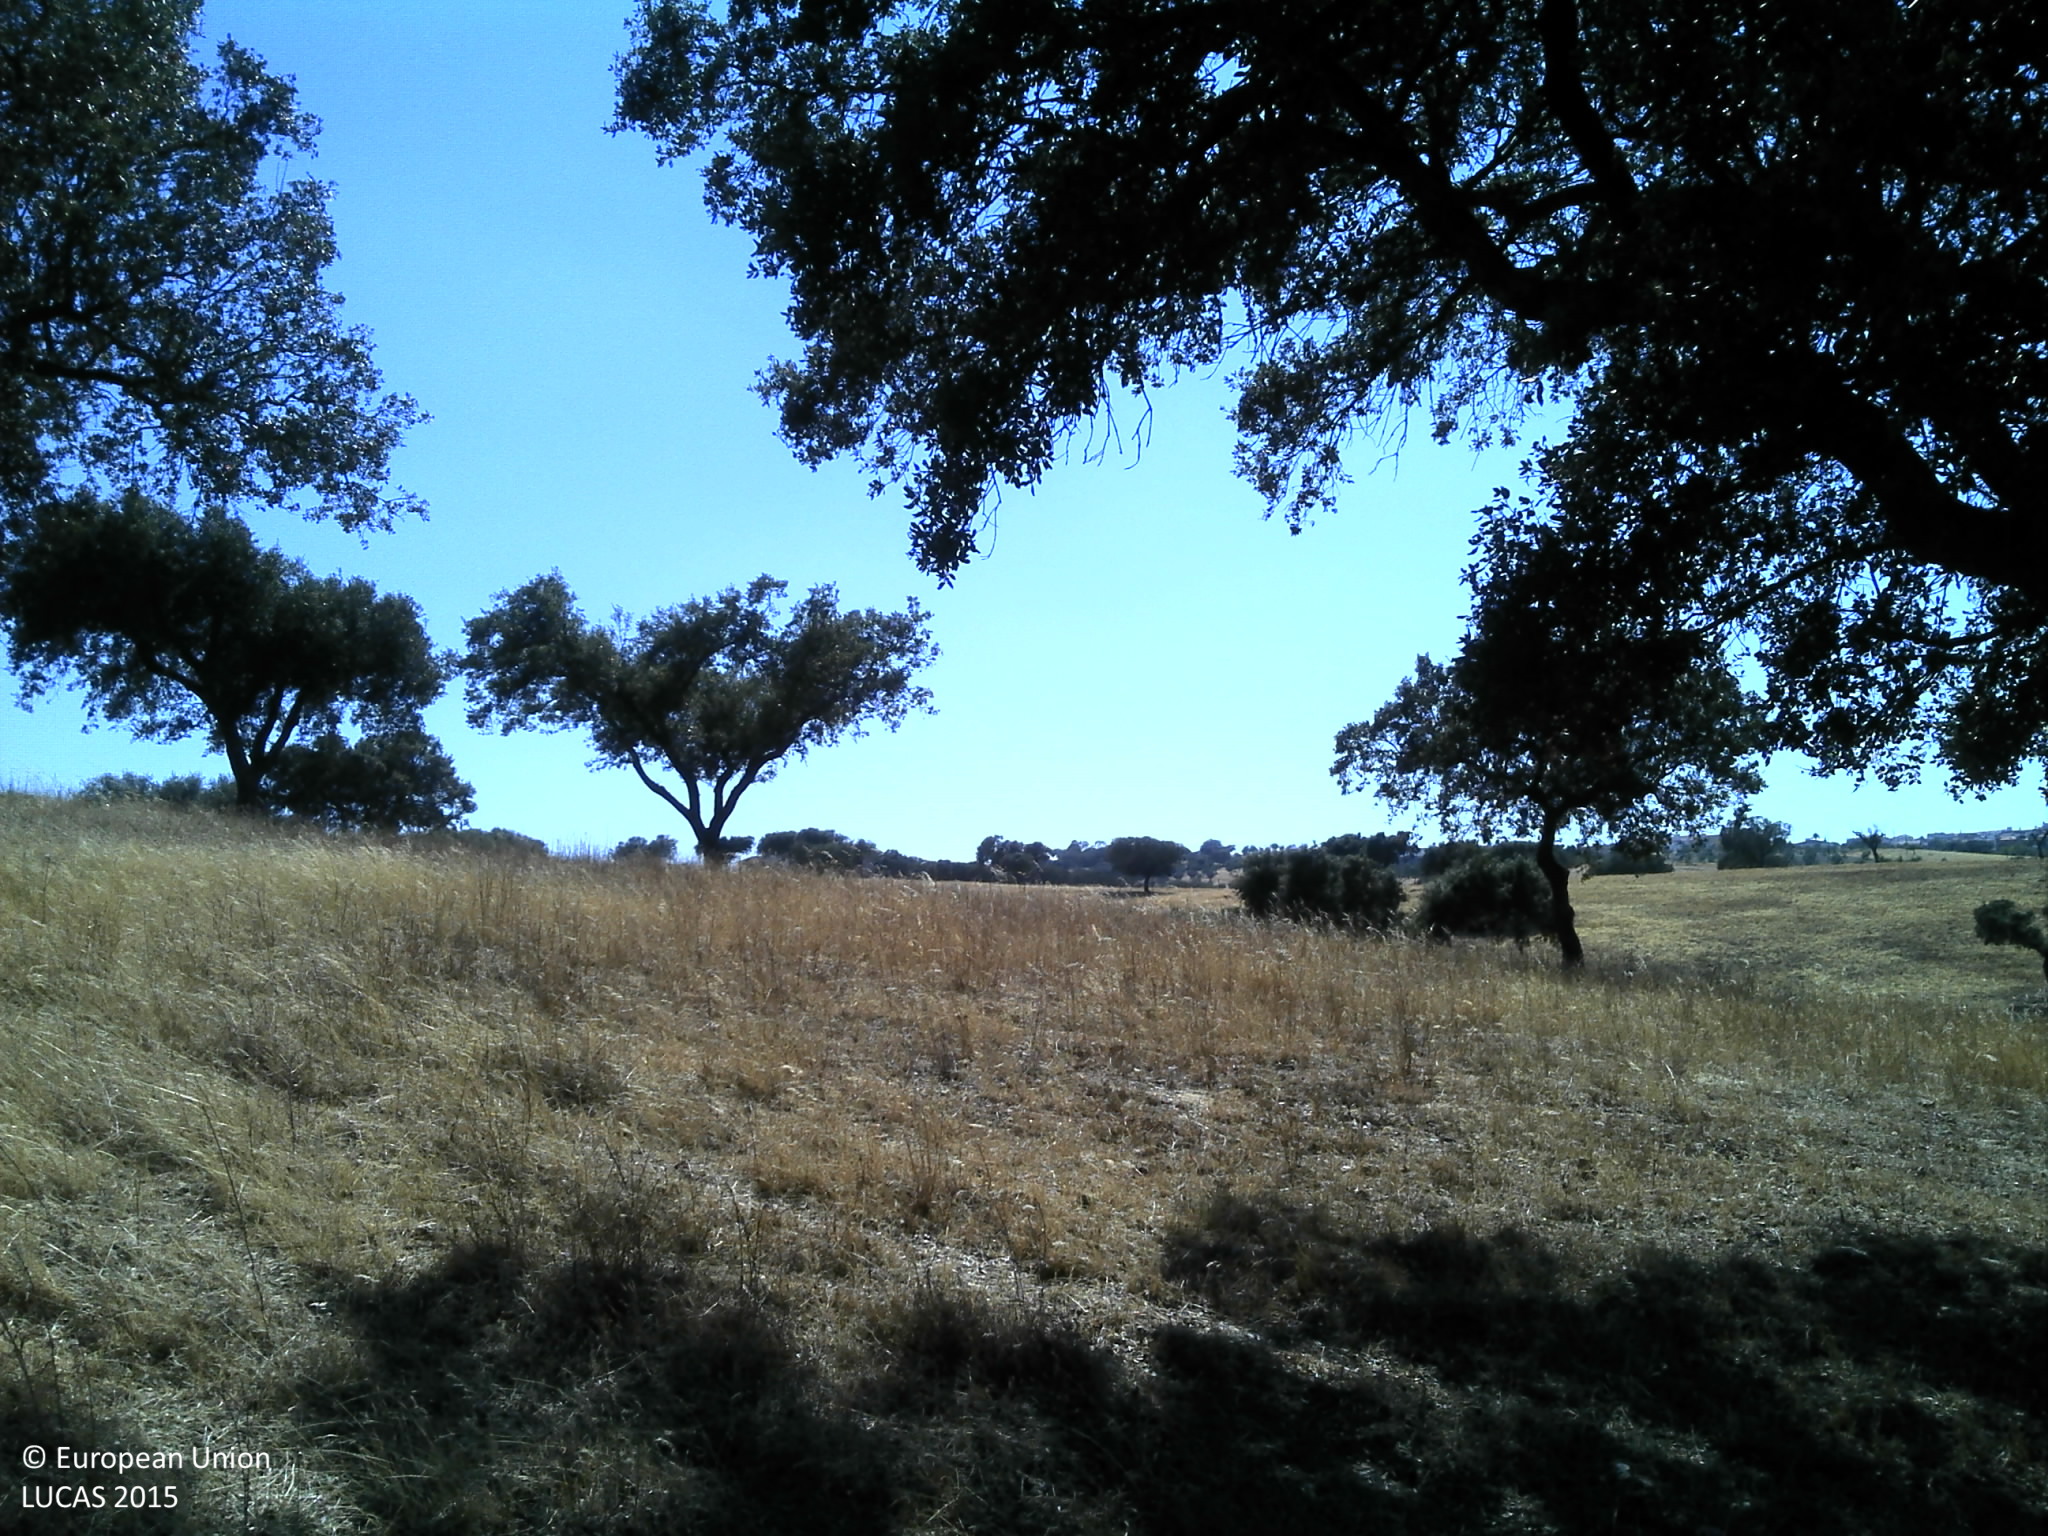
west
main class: Woodland
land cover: Broadleaved woodland
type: broadleaved evergreen forest
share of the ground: 10 - 25 %
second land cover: Grassland without tree/shrub cover
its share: 25 - 50 %
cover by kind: unconsolidated bare surface 50 %, herbaceous plants 30 %, broadleaved forest trees 20 %
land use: Forestry
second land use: Agriculture (excluding fallow land and kitchen gardens)
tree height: > 5 m
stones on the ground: < 10 %
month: July
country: PT
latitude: 38.5410
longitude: -7.4556
